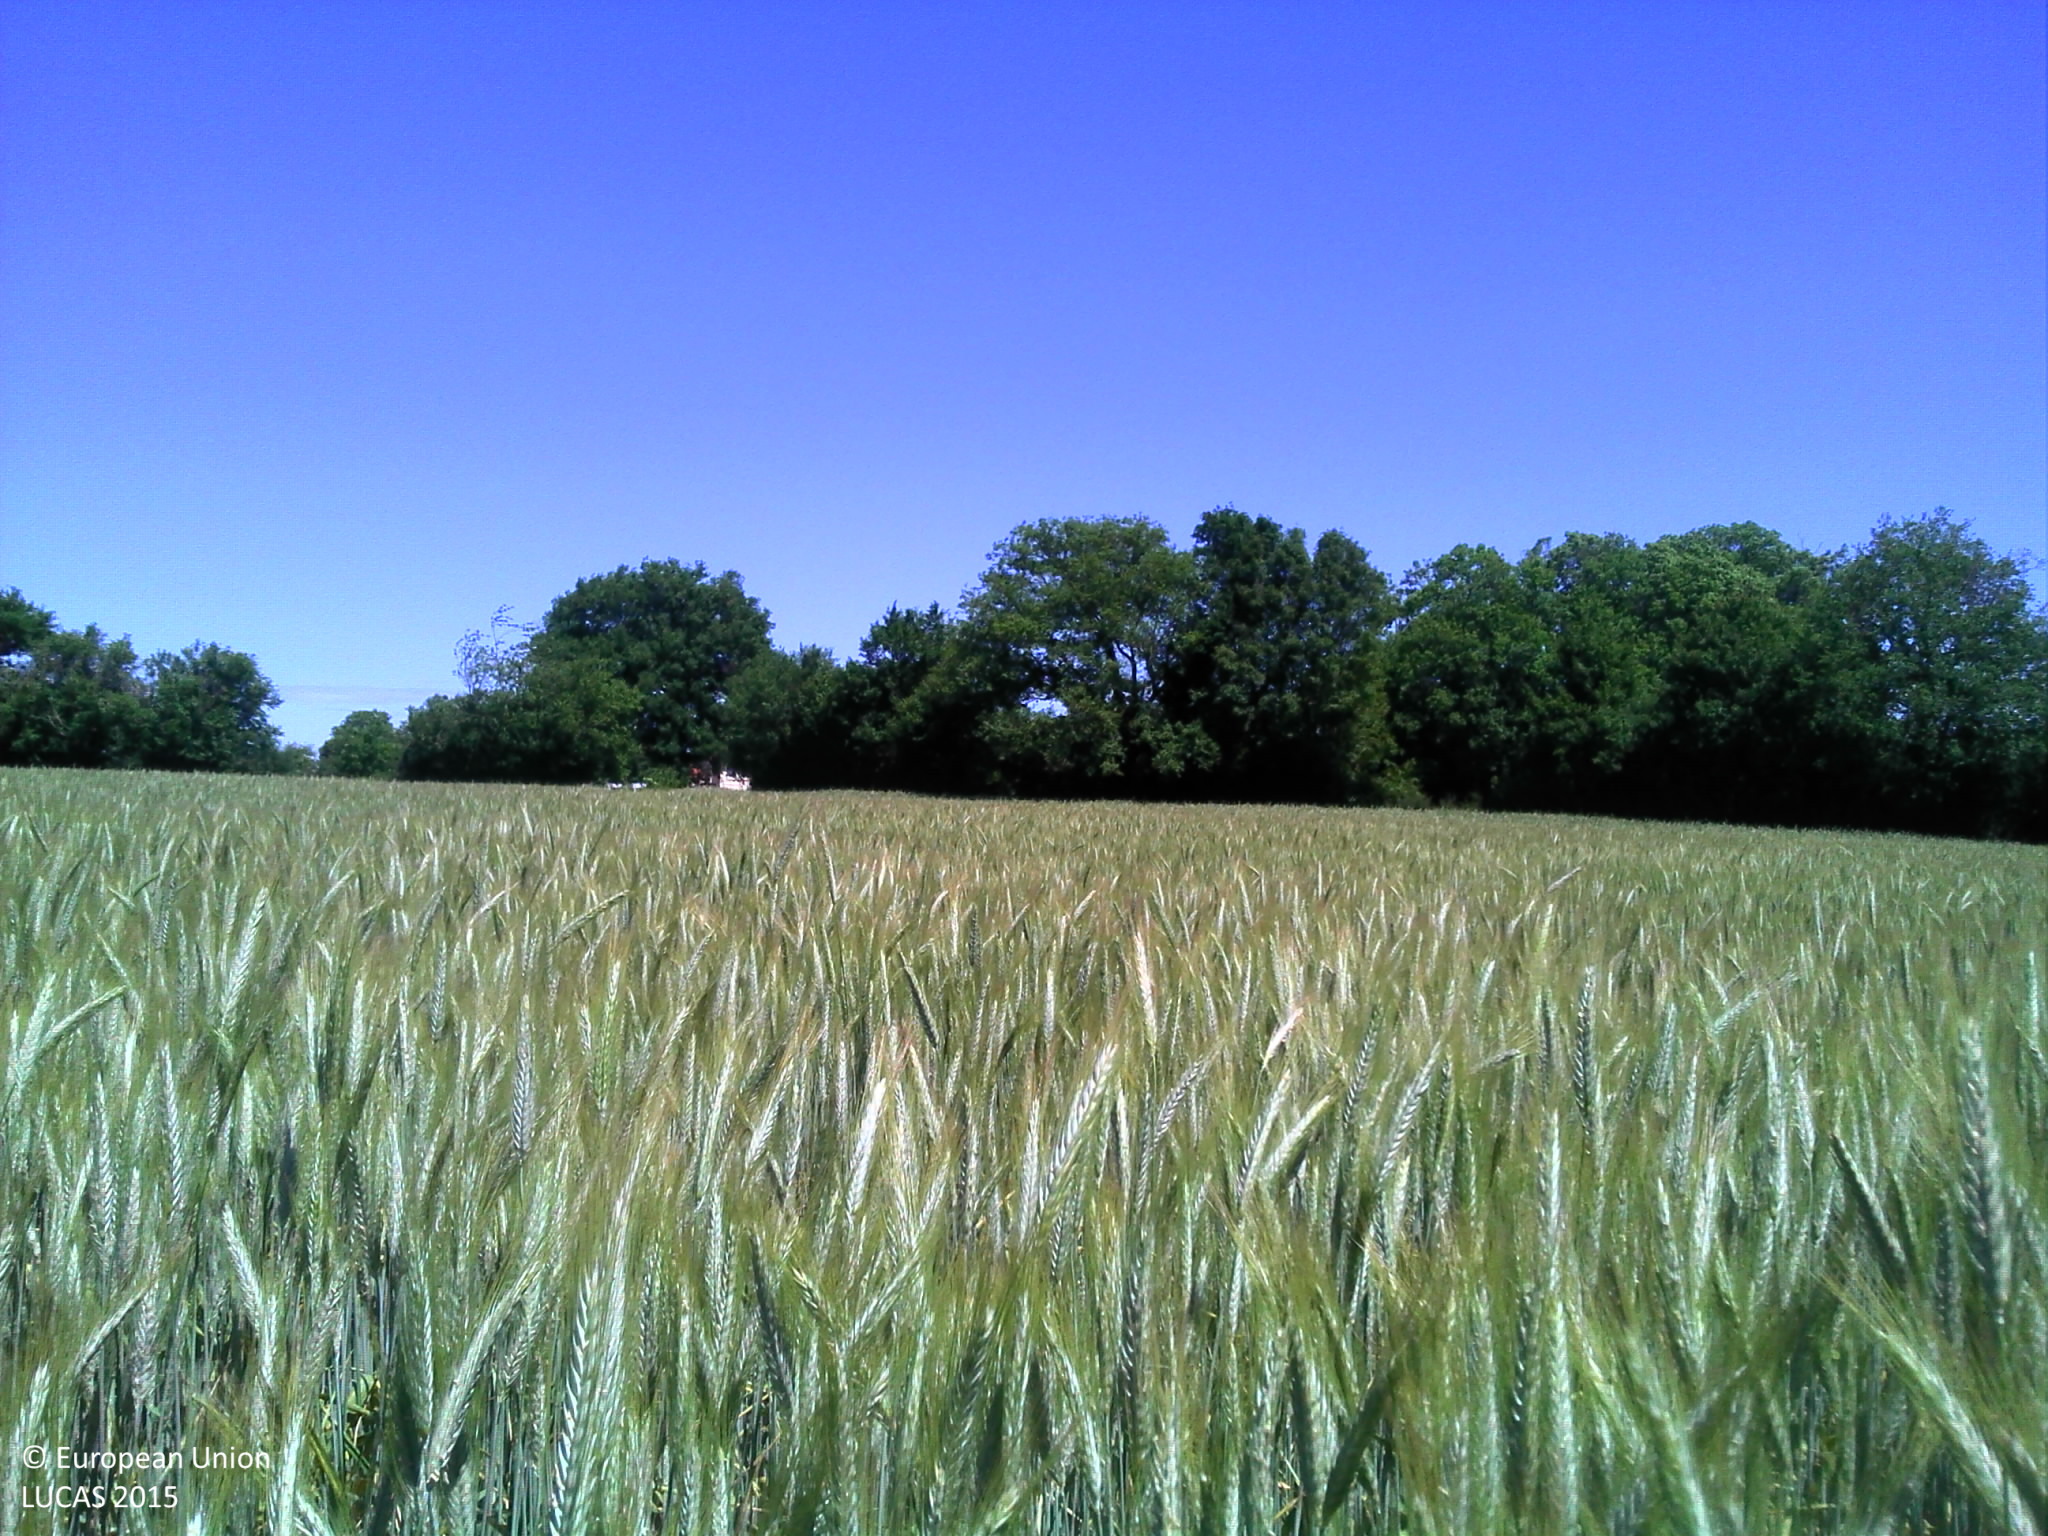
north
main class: Cropland
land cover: Triticale
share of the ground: > 75 %
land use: Agriculture (excluding fallow land and kitchen gardens)
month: June
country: FR
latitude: 46.4372
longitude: 2.3285
